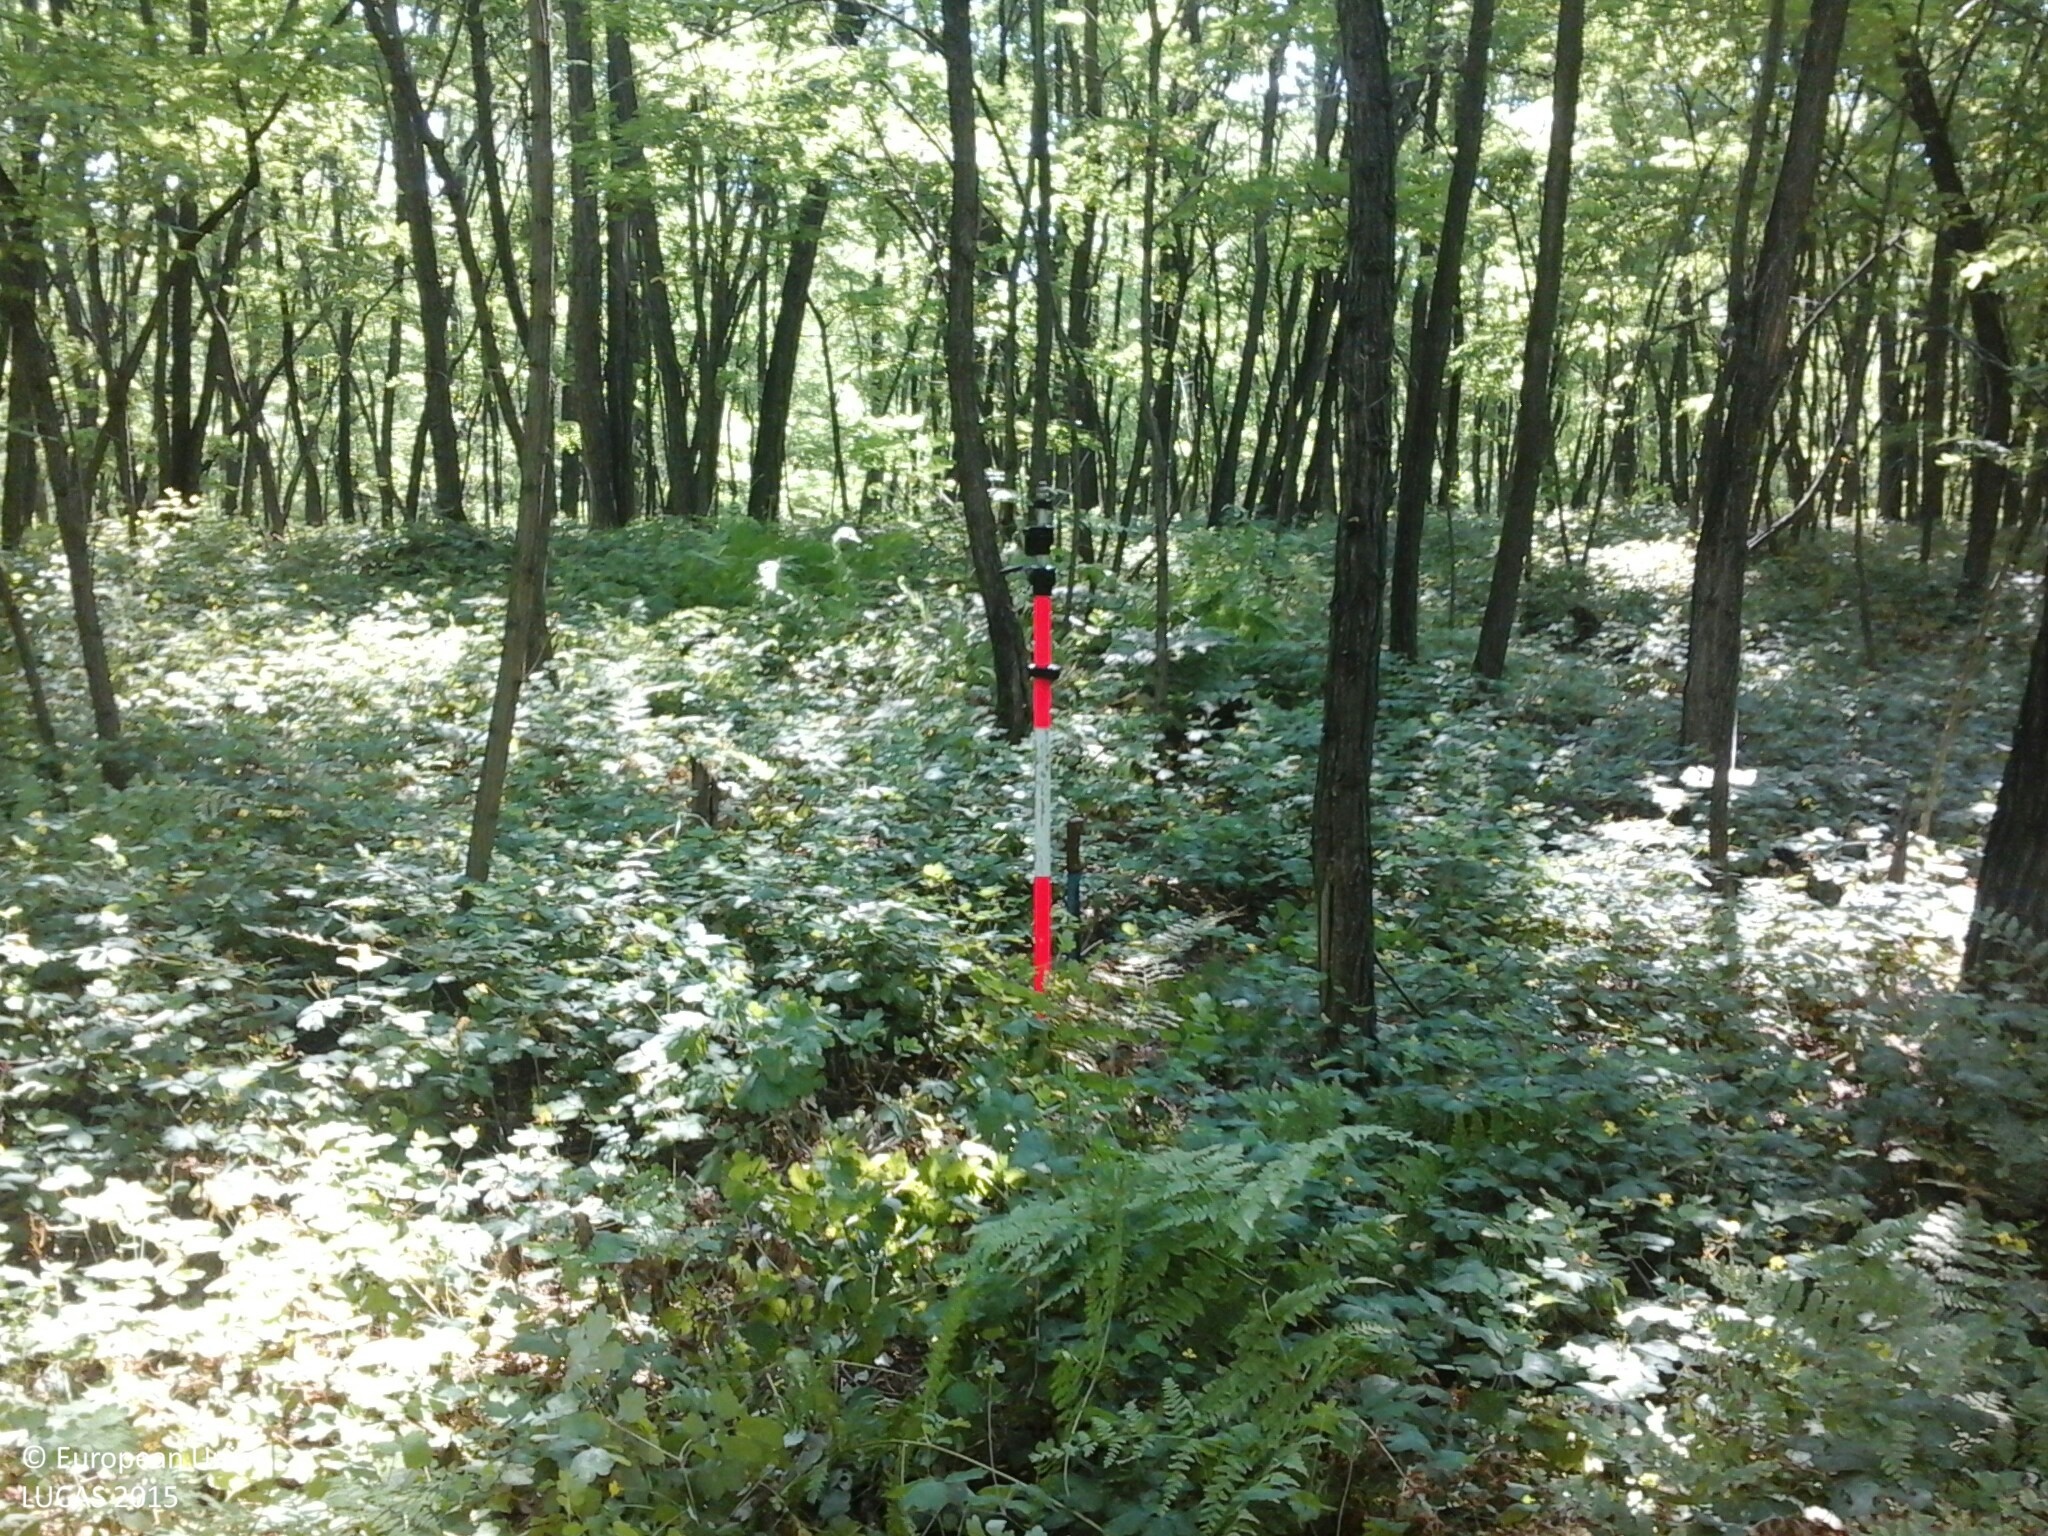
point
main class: Woodland
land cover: Broadleaved woodland
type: exotic forest
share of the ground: > 75 %
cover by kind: broadleaved forest trees 100 %
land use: Forestry
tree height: > 5 m
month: July
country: HU
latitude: 48.1414
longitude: 22.2184
